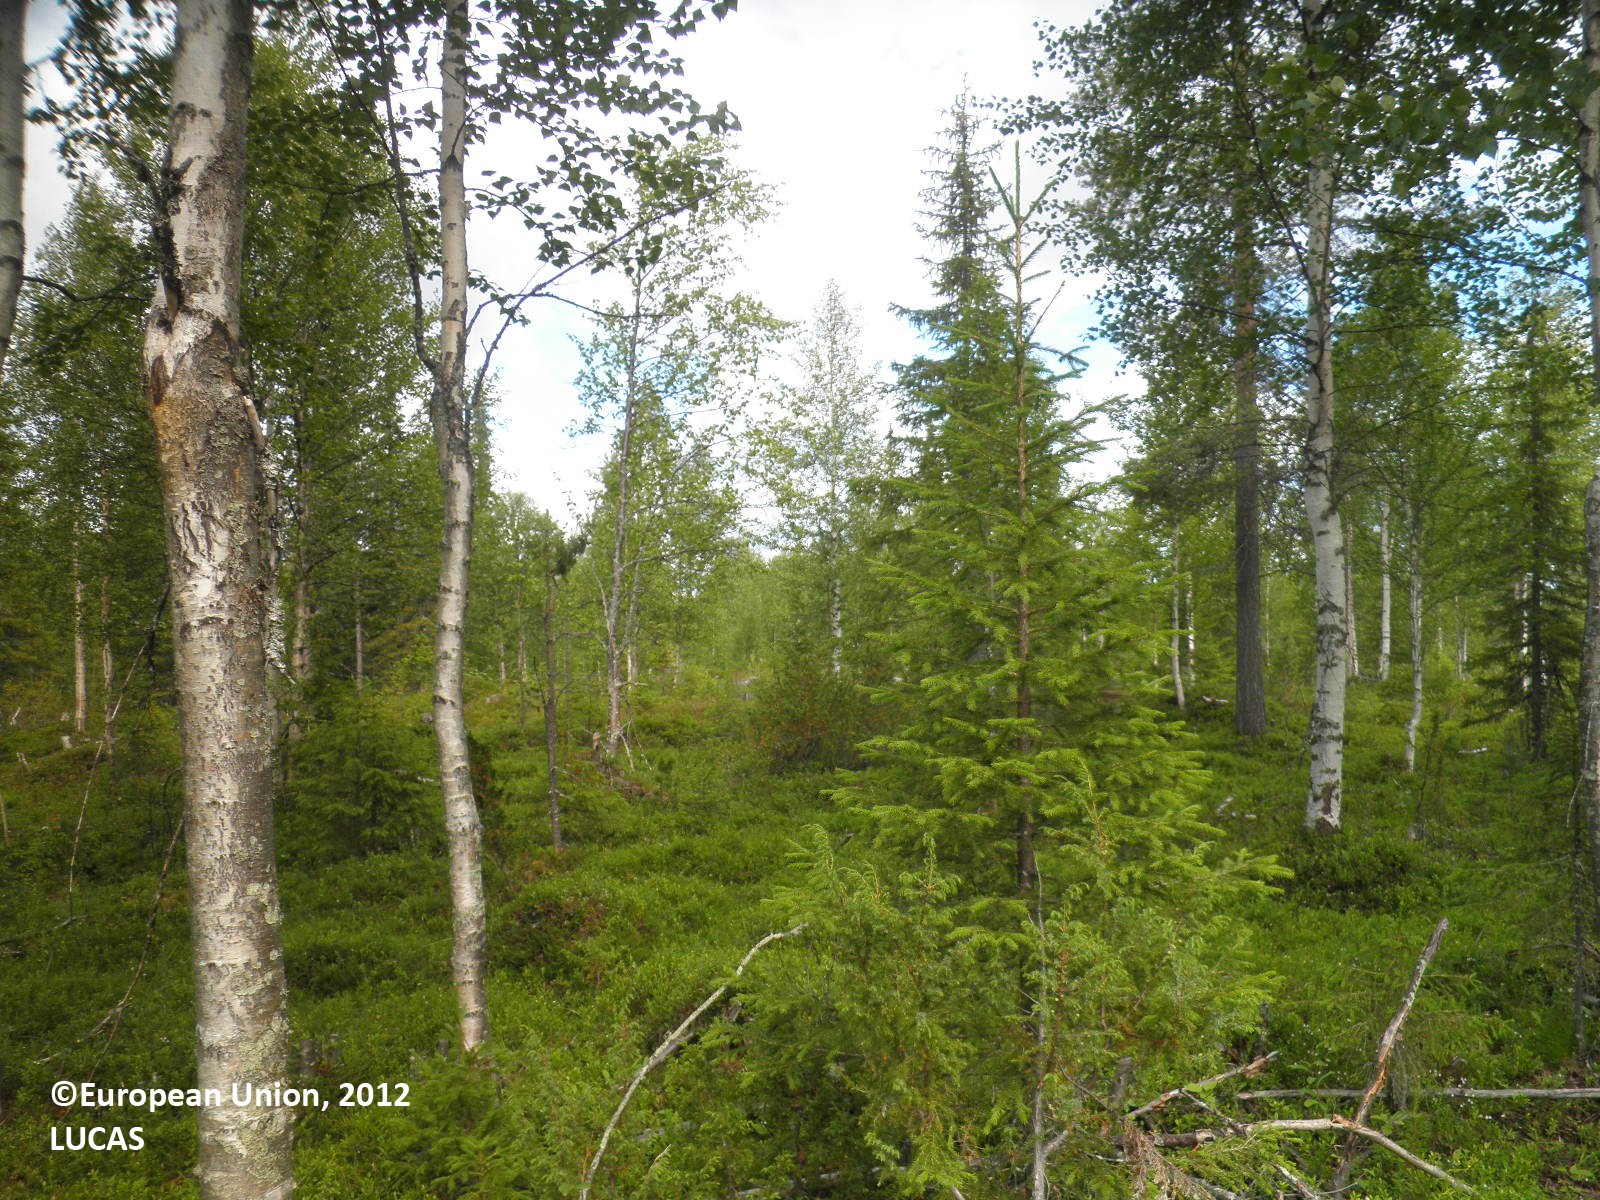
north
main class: Woodland
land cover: Broadleaved woodland
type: boreal forest
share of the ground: 50 - 75 %
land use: Forestry
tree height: > 5 m
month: July
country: FI
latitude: 67.6860
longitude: 26.1322
